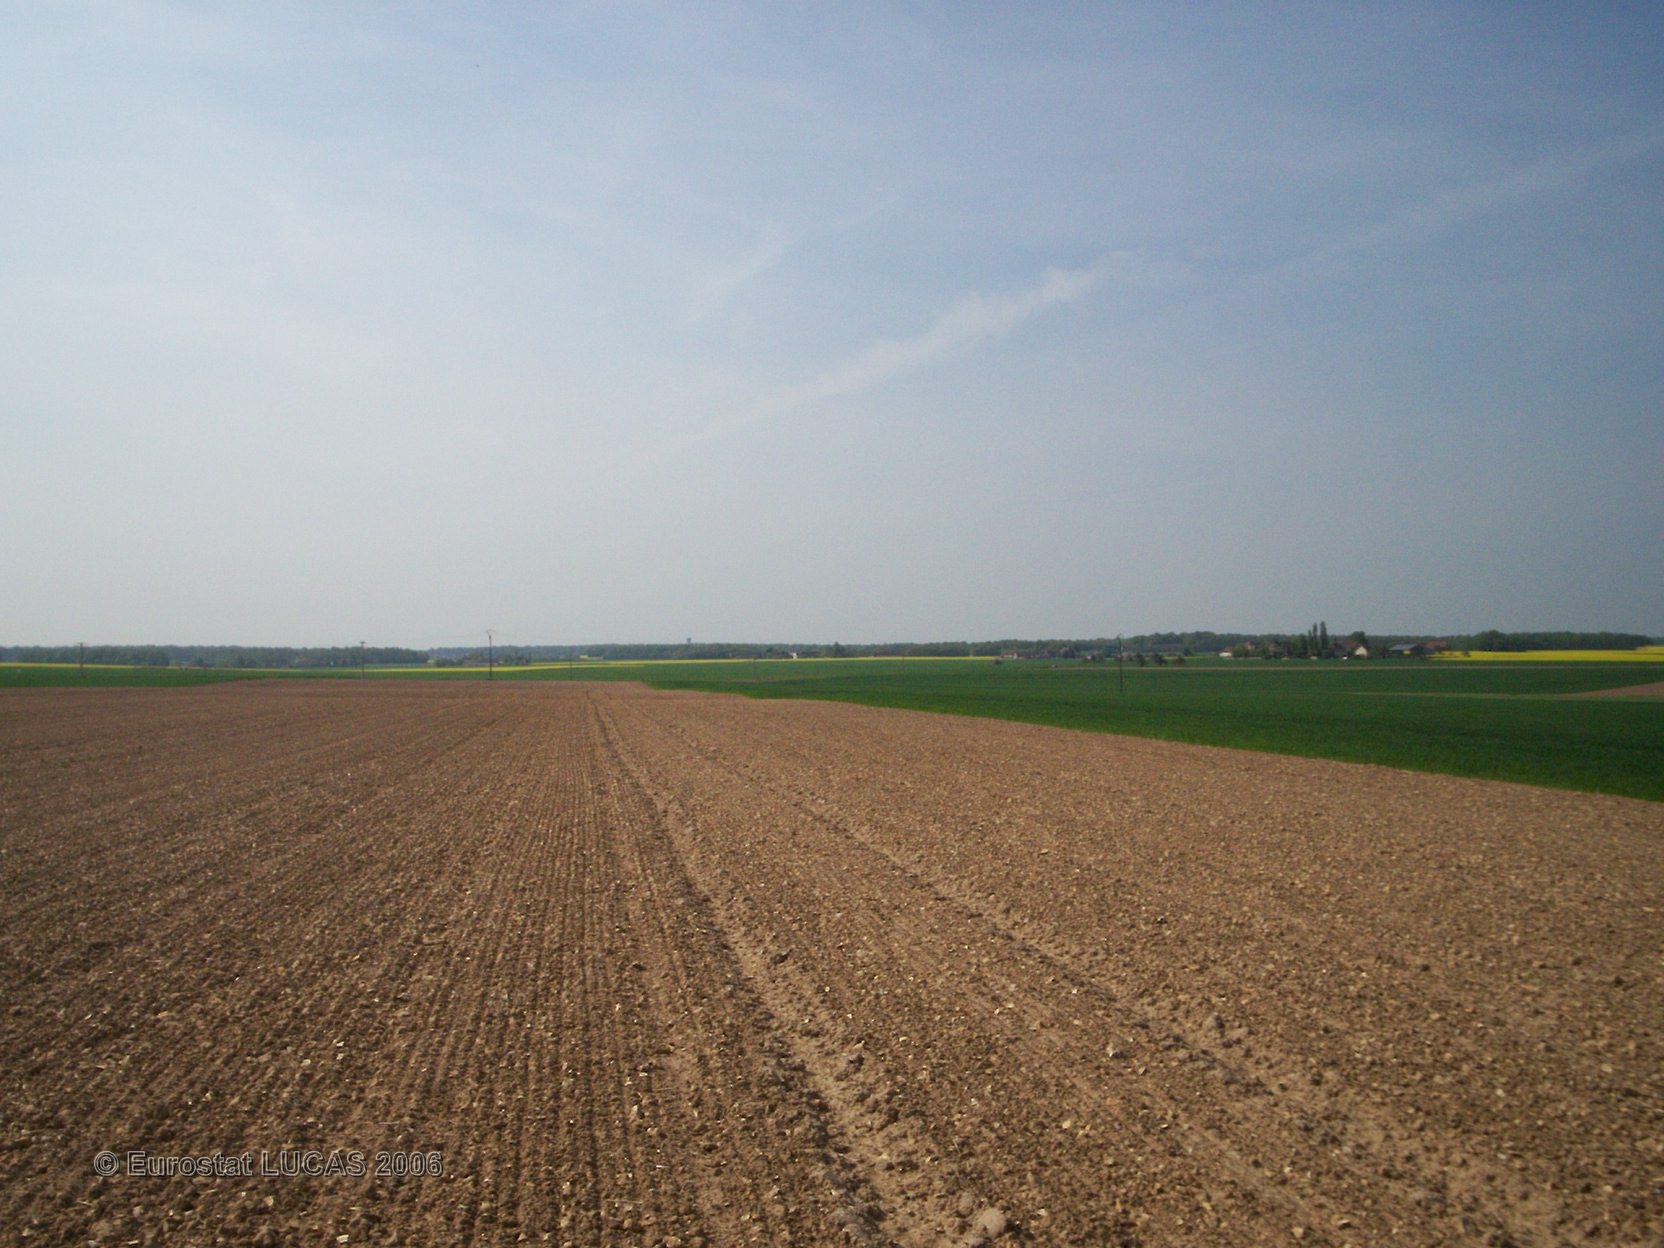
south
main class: Cropland
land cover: Sunflower
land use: Agriculture (excluding fallow land and kitchen gardens)
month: May
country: FR
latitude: 48.0502
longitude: 2.9225
